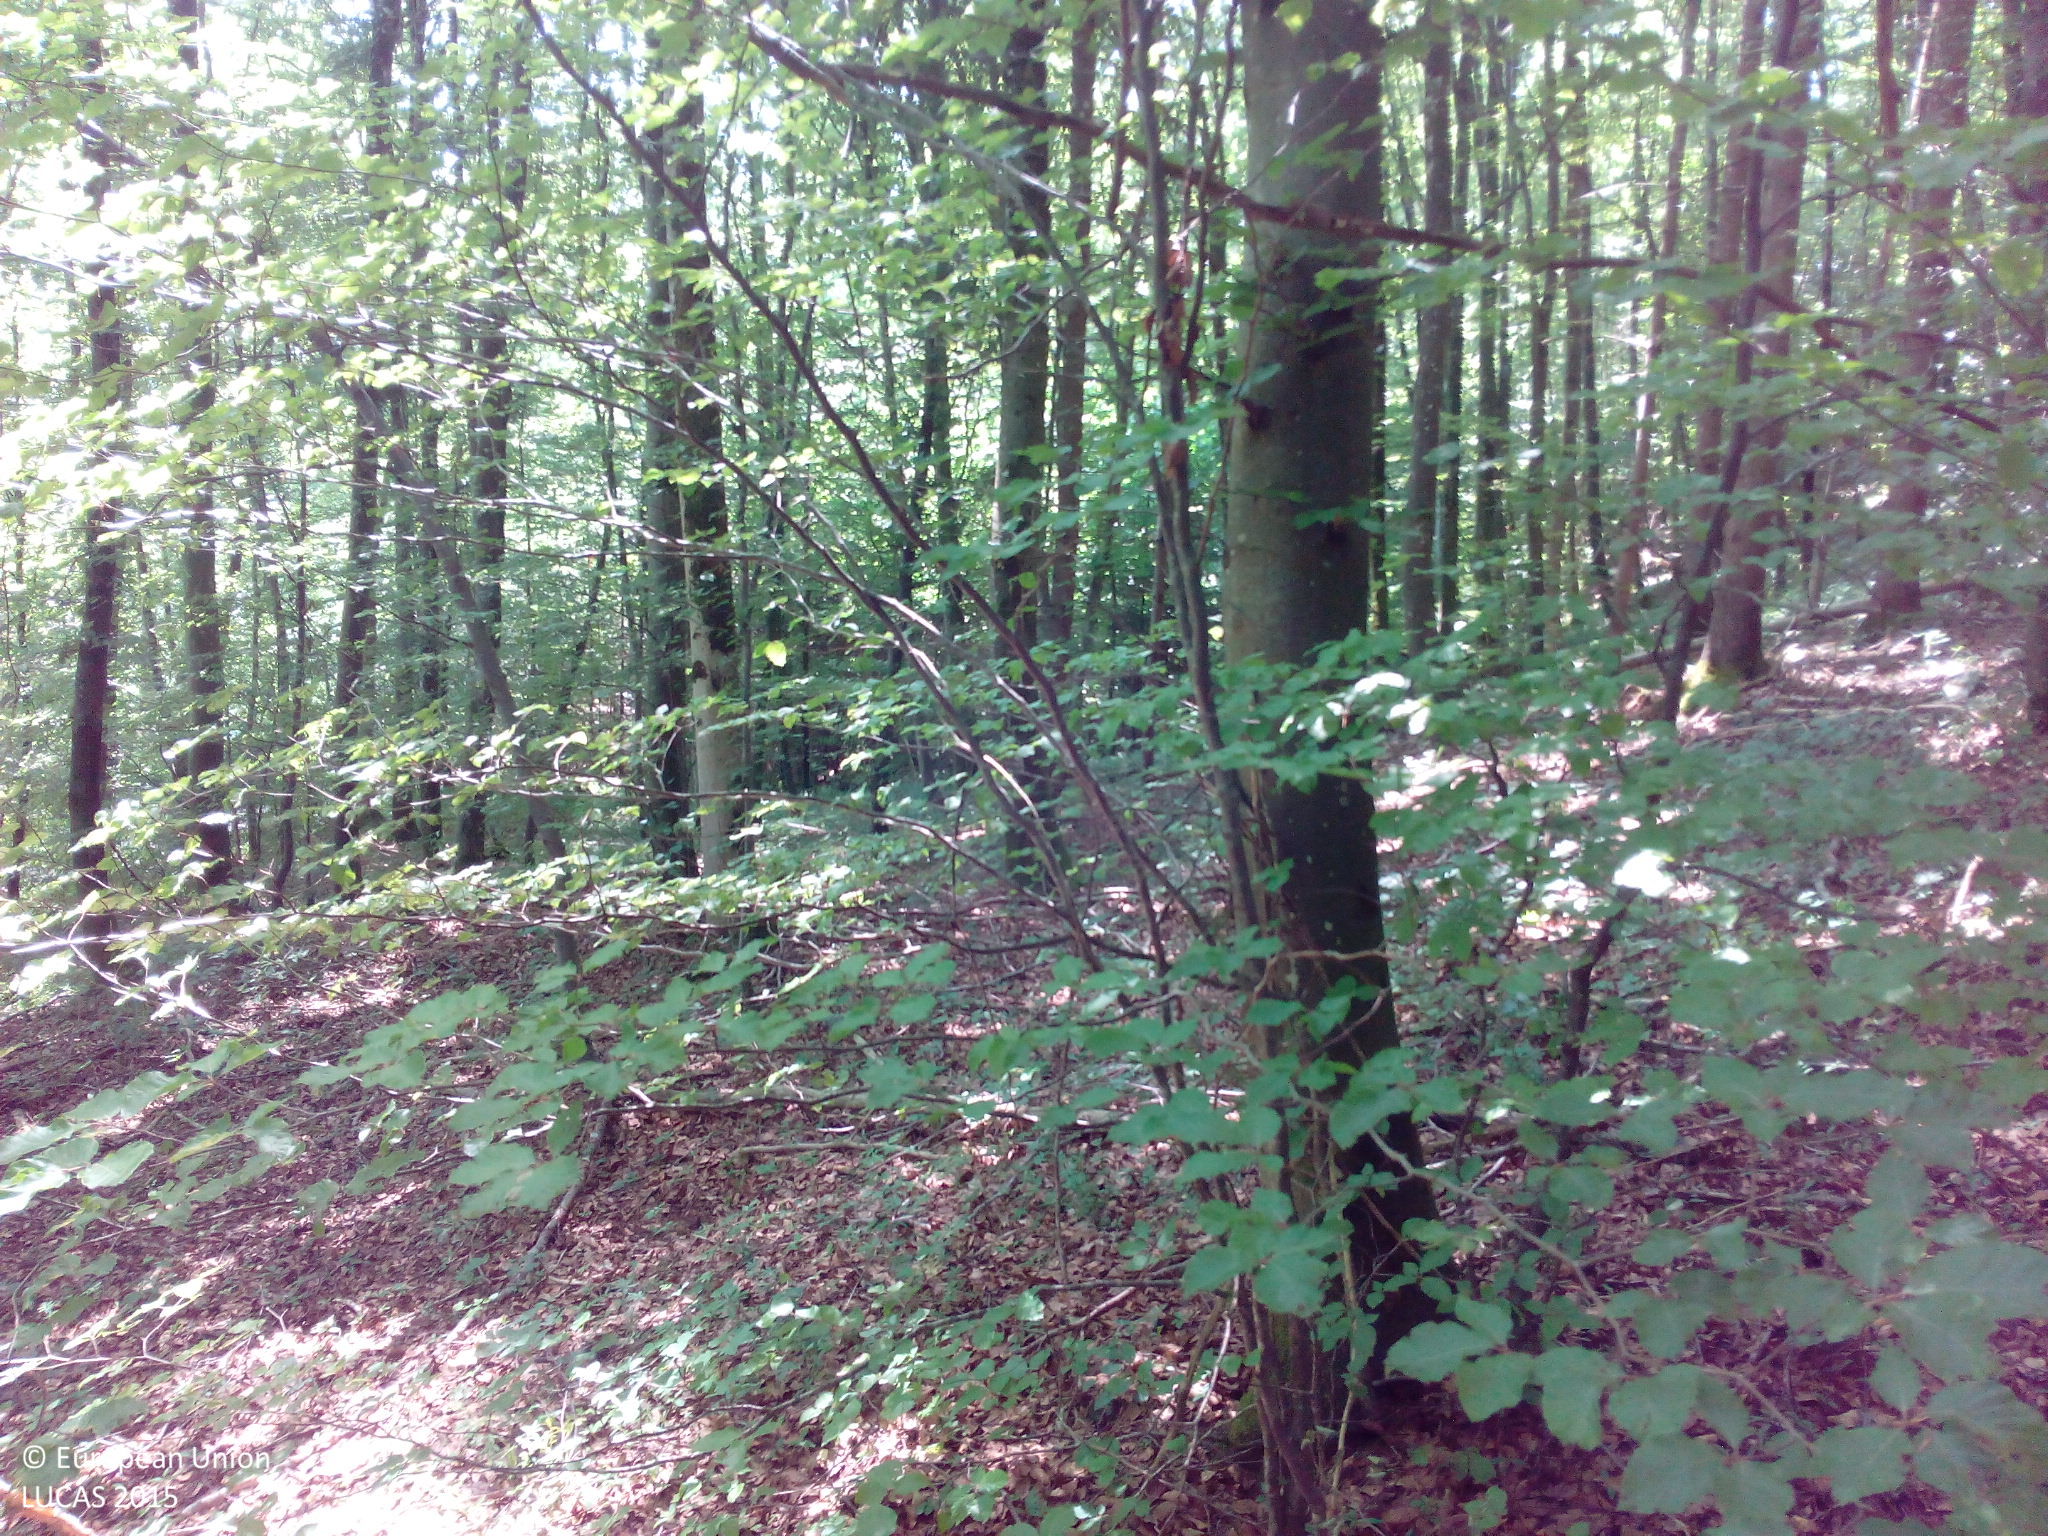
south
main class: Woodland
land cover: Broadleaved woodland
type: mesophytic deciduous forest
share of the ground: > 75 %
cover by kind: broadleaved forest trees 100 %
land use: Forestry
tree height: > 5 m
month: July
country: DE
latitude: 48.2220
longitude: 9.4216
